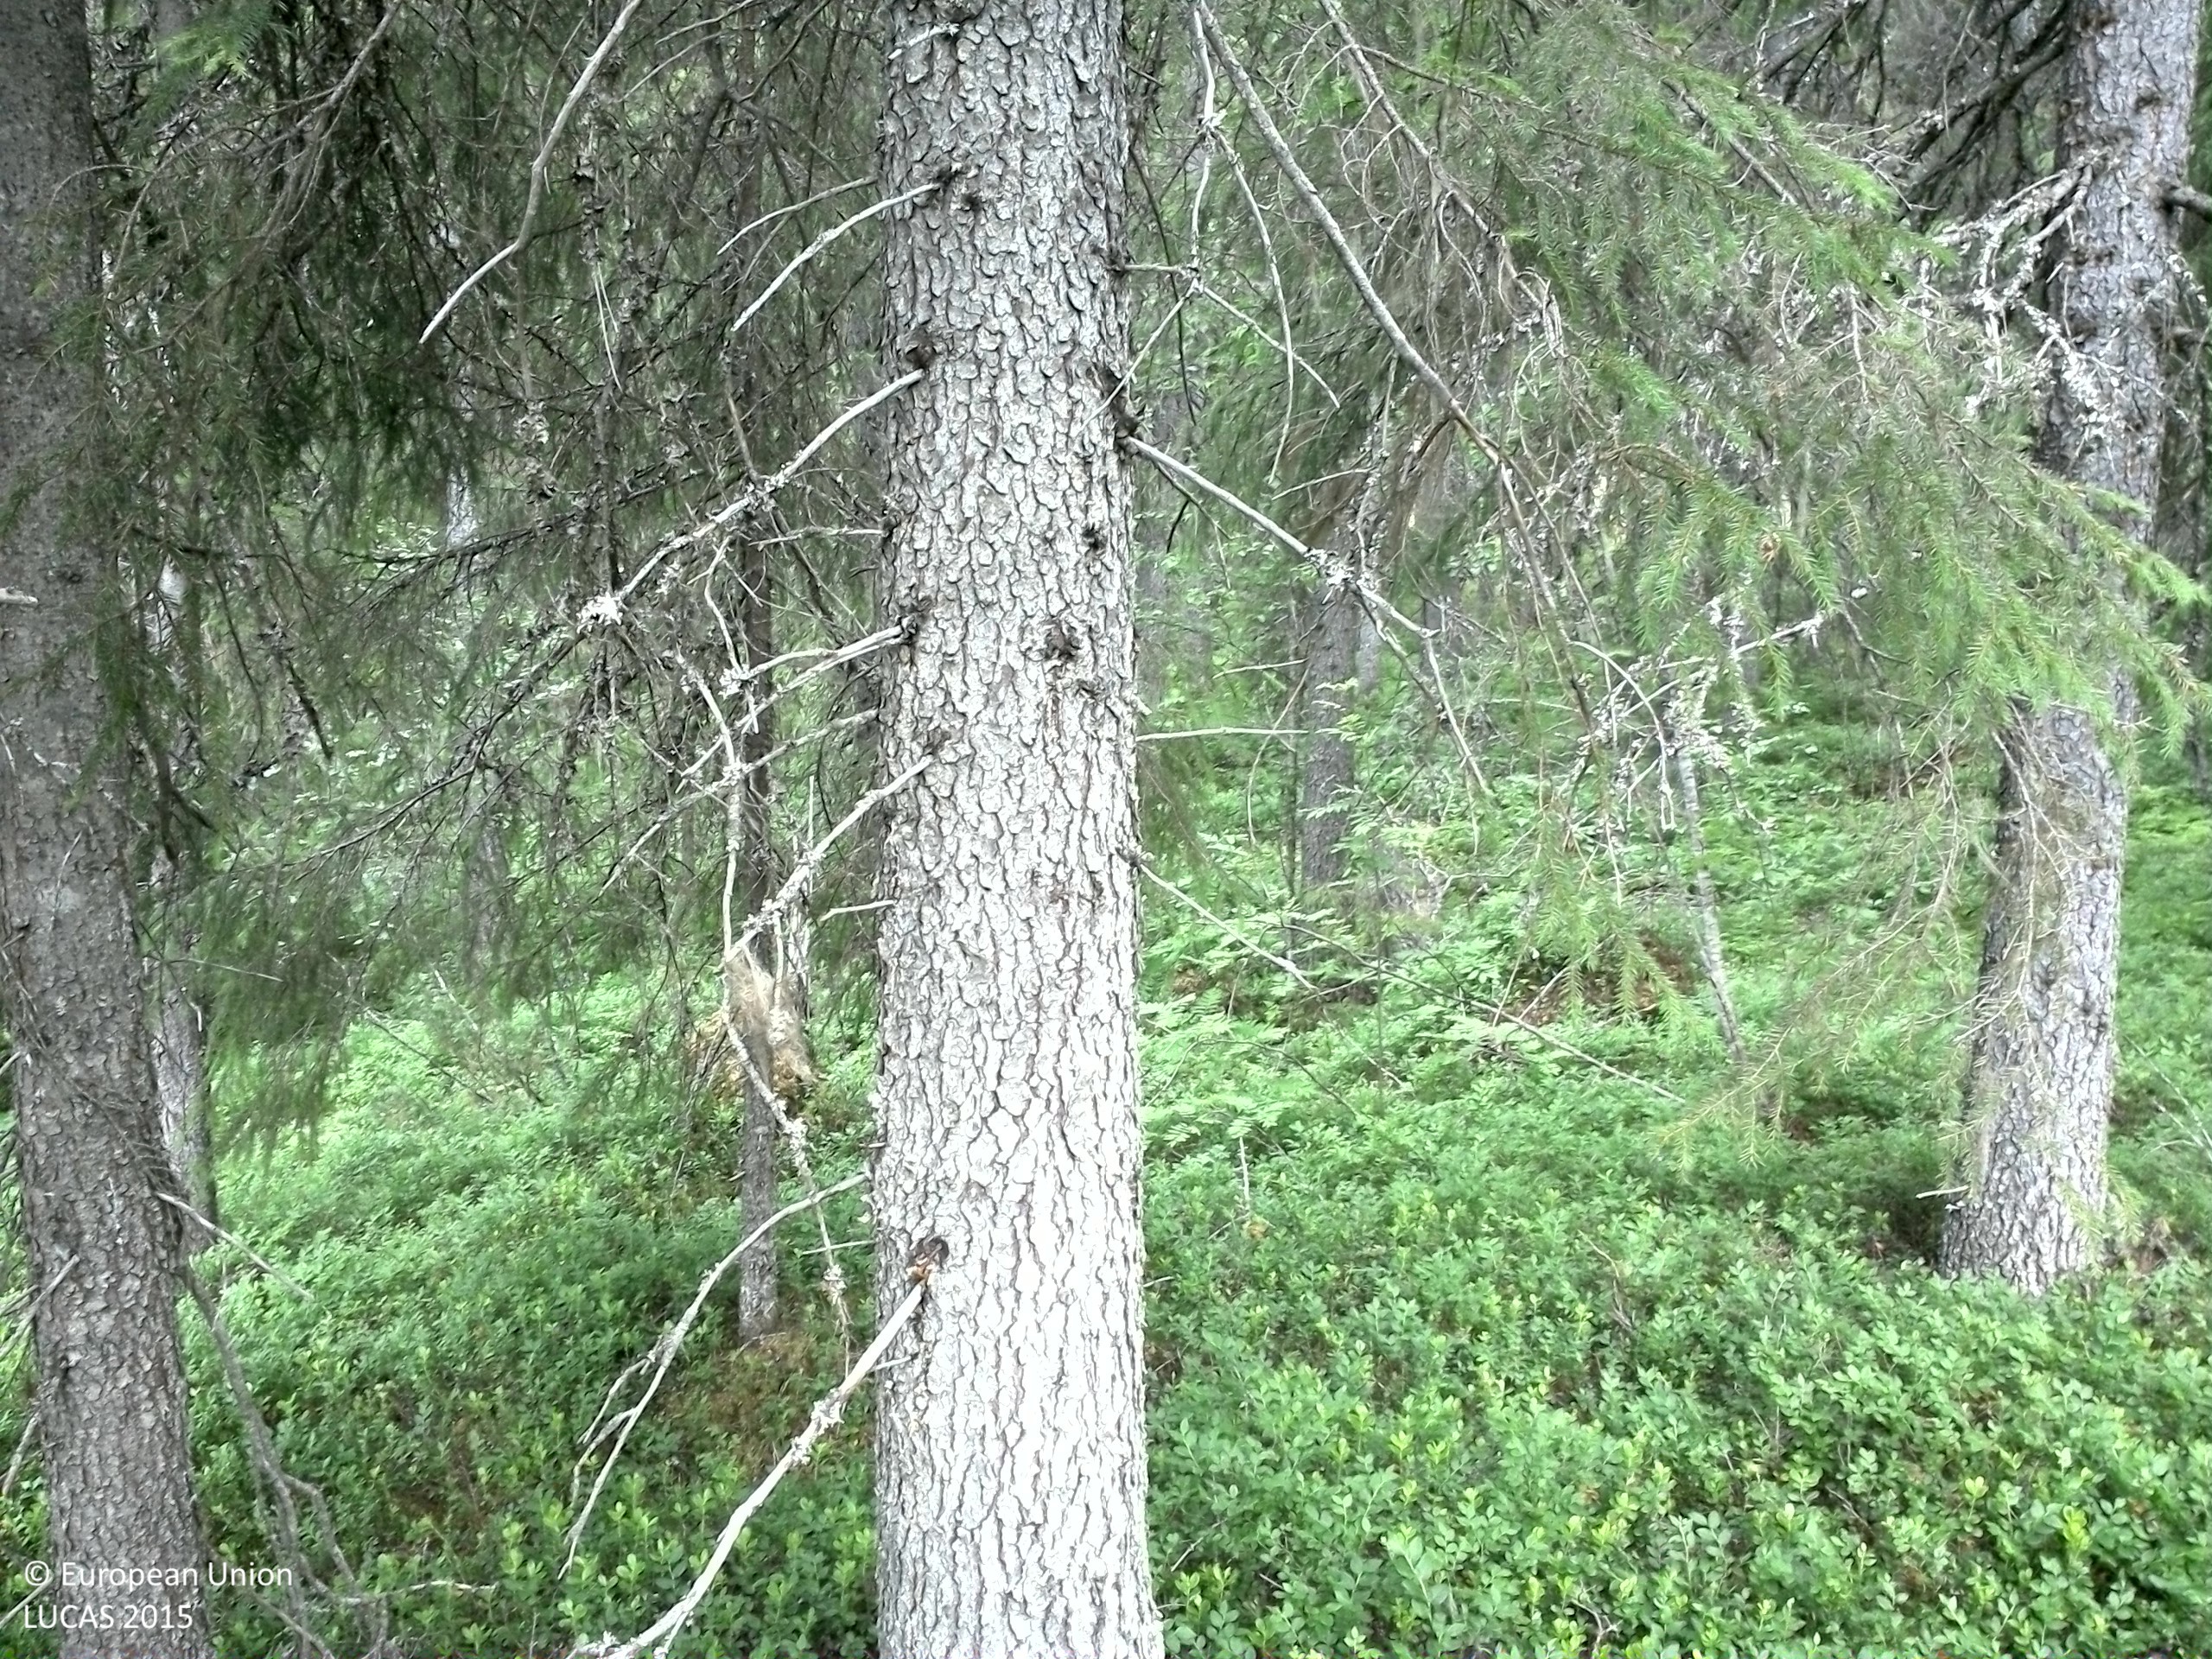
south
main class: Woodland
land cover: Spruce dominated coniferous woodland
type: boreal forest
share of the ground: 50 - 75 %
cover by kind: coniferous forest trees 60 %, shrubs 30 %, broadleaved forest trees 5 %, herbaceous plants 5 %
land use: Forestry
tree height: > 5 m
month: July
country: SE
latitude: 64.4127
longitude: 15.9668
